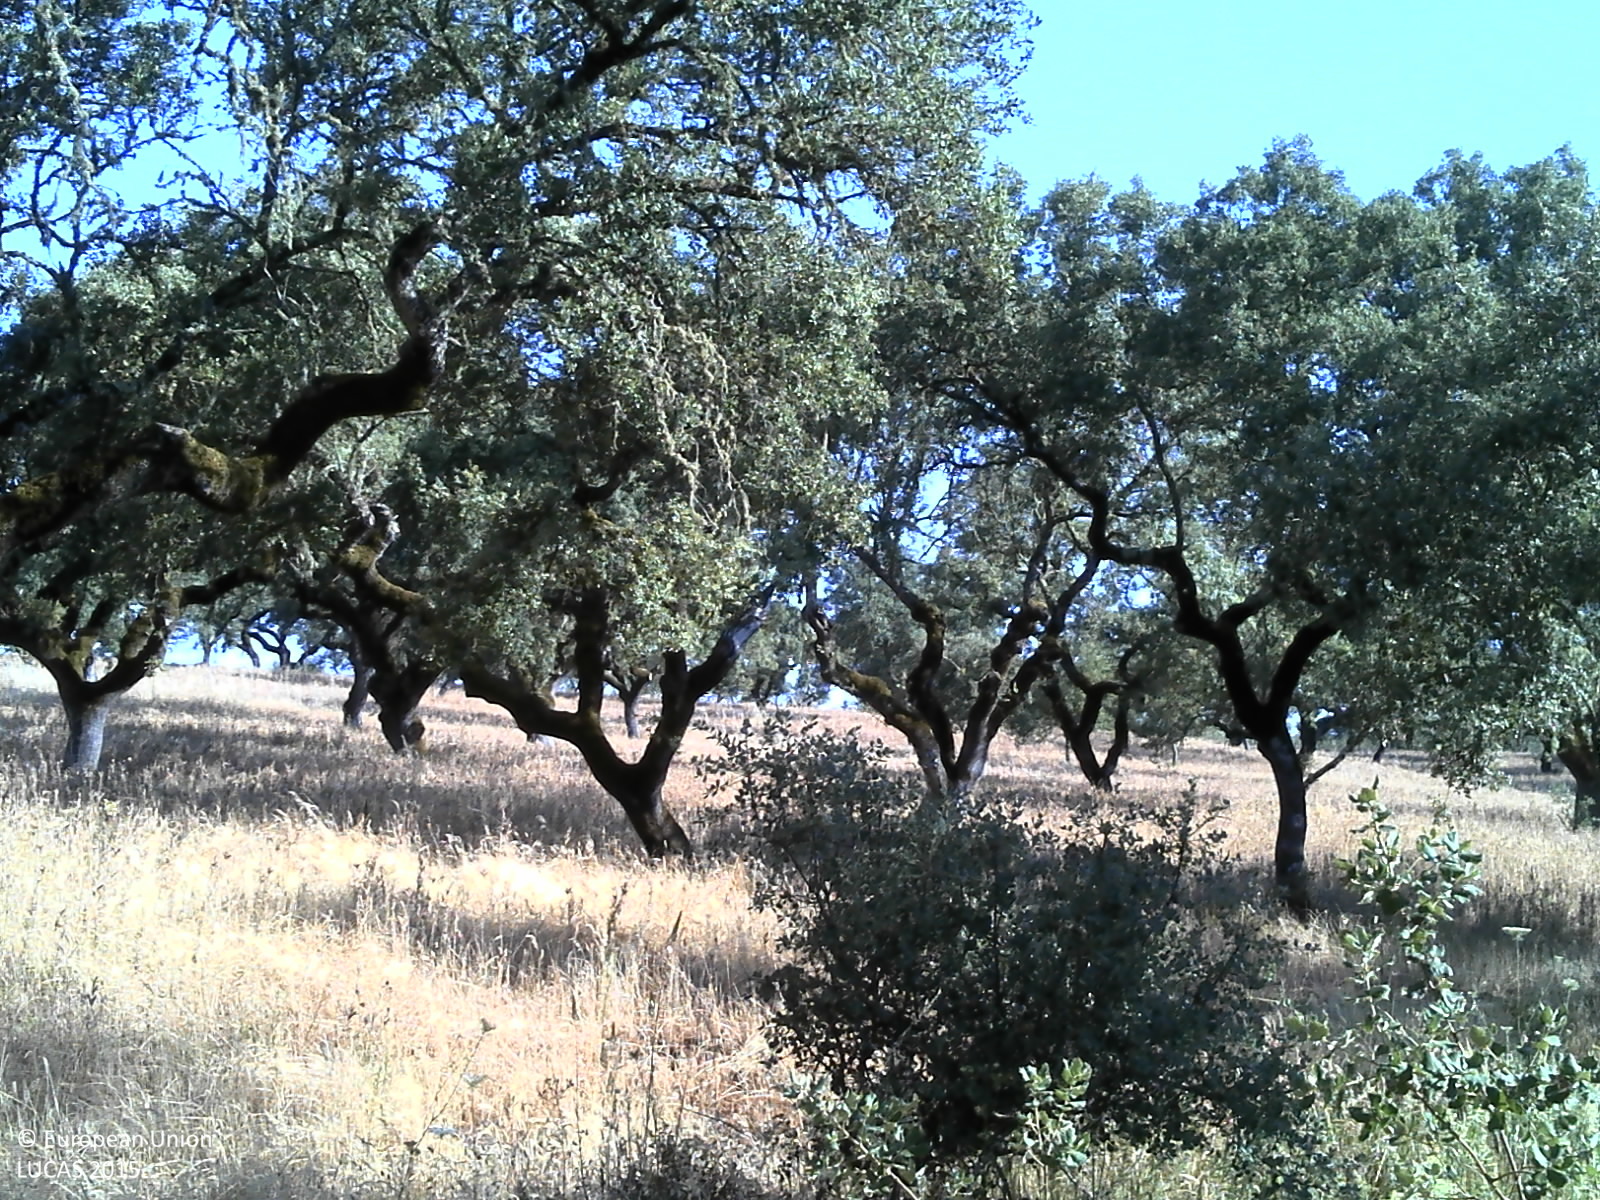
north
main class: Woodland
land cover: Broadleaved woodland
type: broadleaved evergreen forest
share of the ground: > 75 %
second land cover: Other leguminous and mixtures for fodder
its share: > 75 %
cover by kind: broadleaved forest trees 75 %, herbaceous plants 25 %
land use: Forestry
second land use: Agriculture (excluding fallow land and kitchen gardens)
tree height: > 5 m
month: June
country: PT
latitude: 38.6647
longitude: -8.0774
